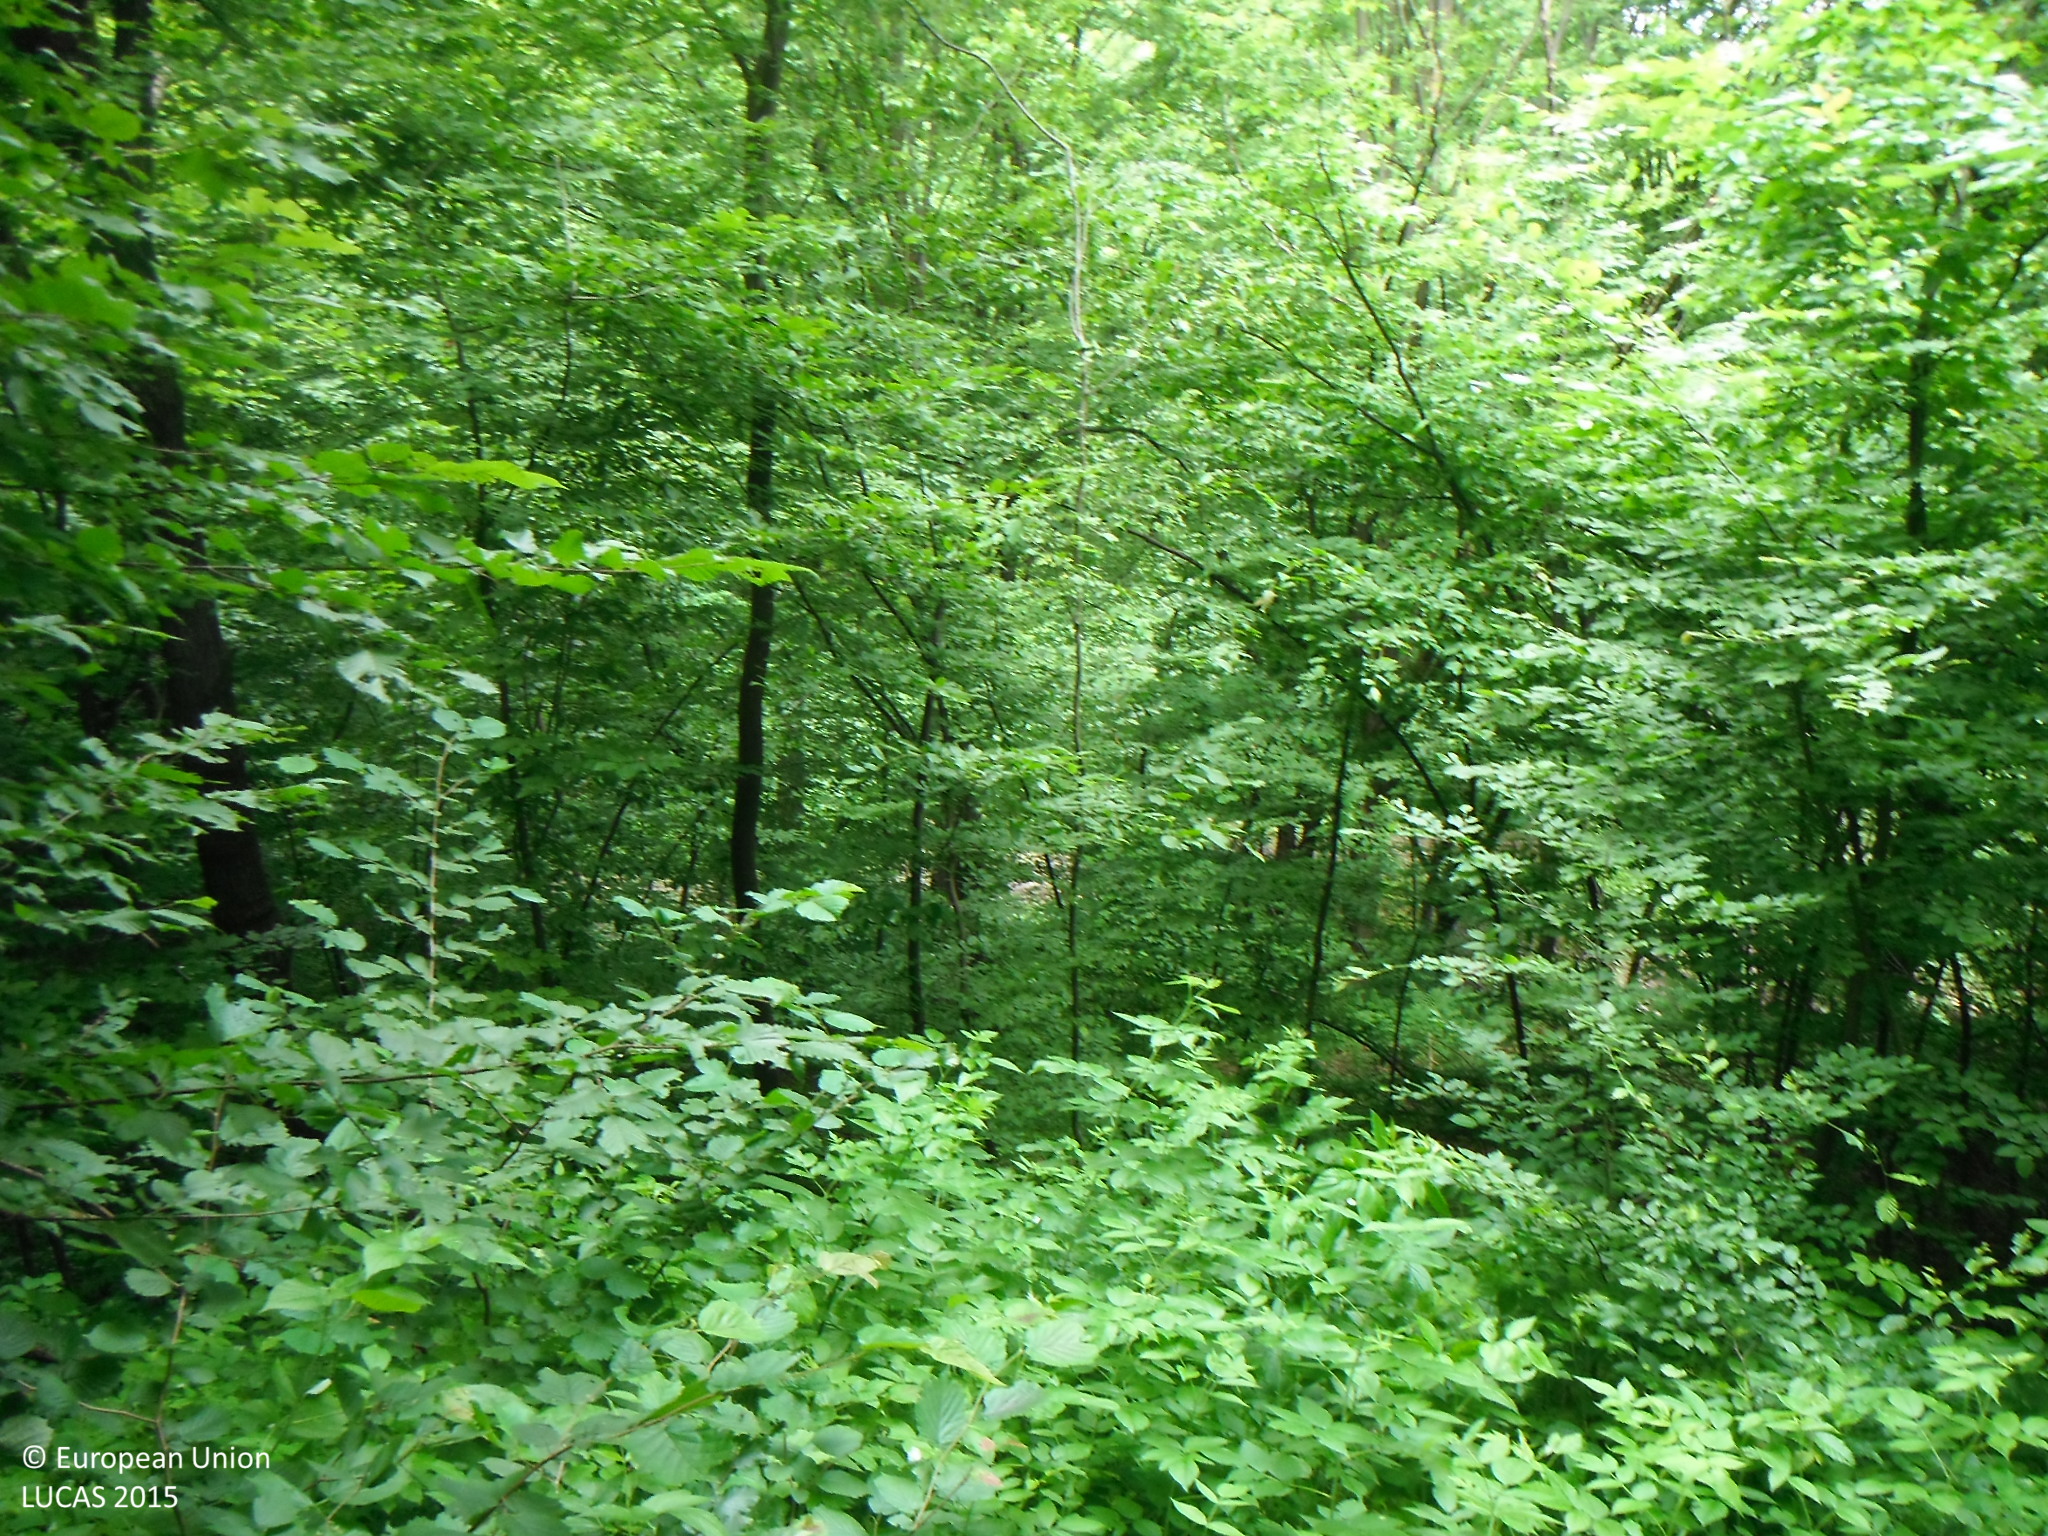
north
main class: Woodland
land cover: Broadleaved woodland
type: mesophytic deciduous forest
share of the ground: > 75 %
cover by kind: broadleaved forest trees 90 %, herbaceous plants 10 %
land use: Forestry
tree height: > 5 m
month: June
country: SK
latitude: 48.6246
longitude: 19.9468
